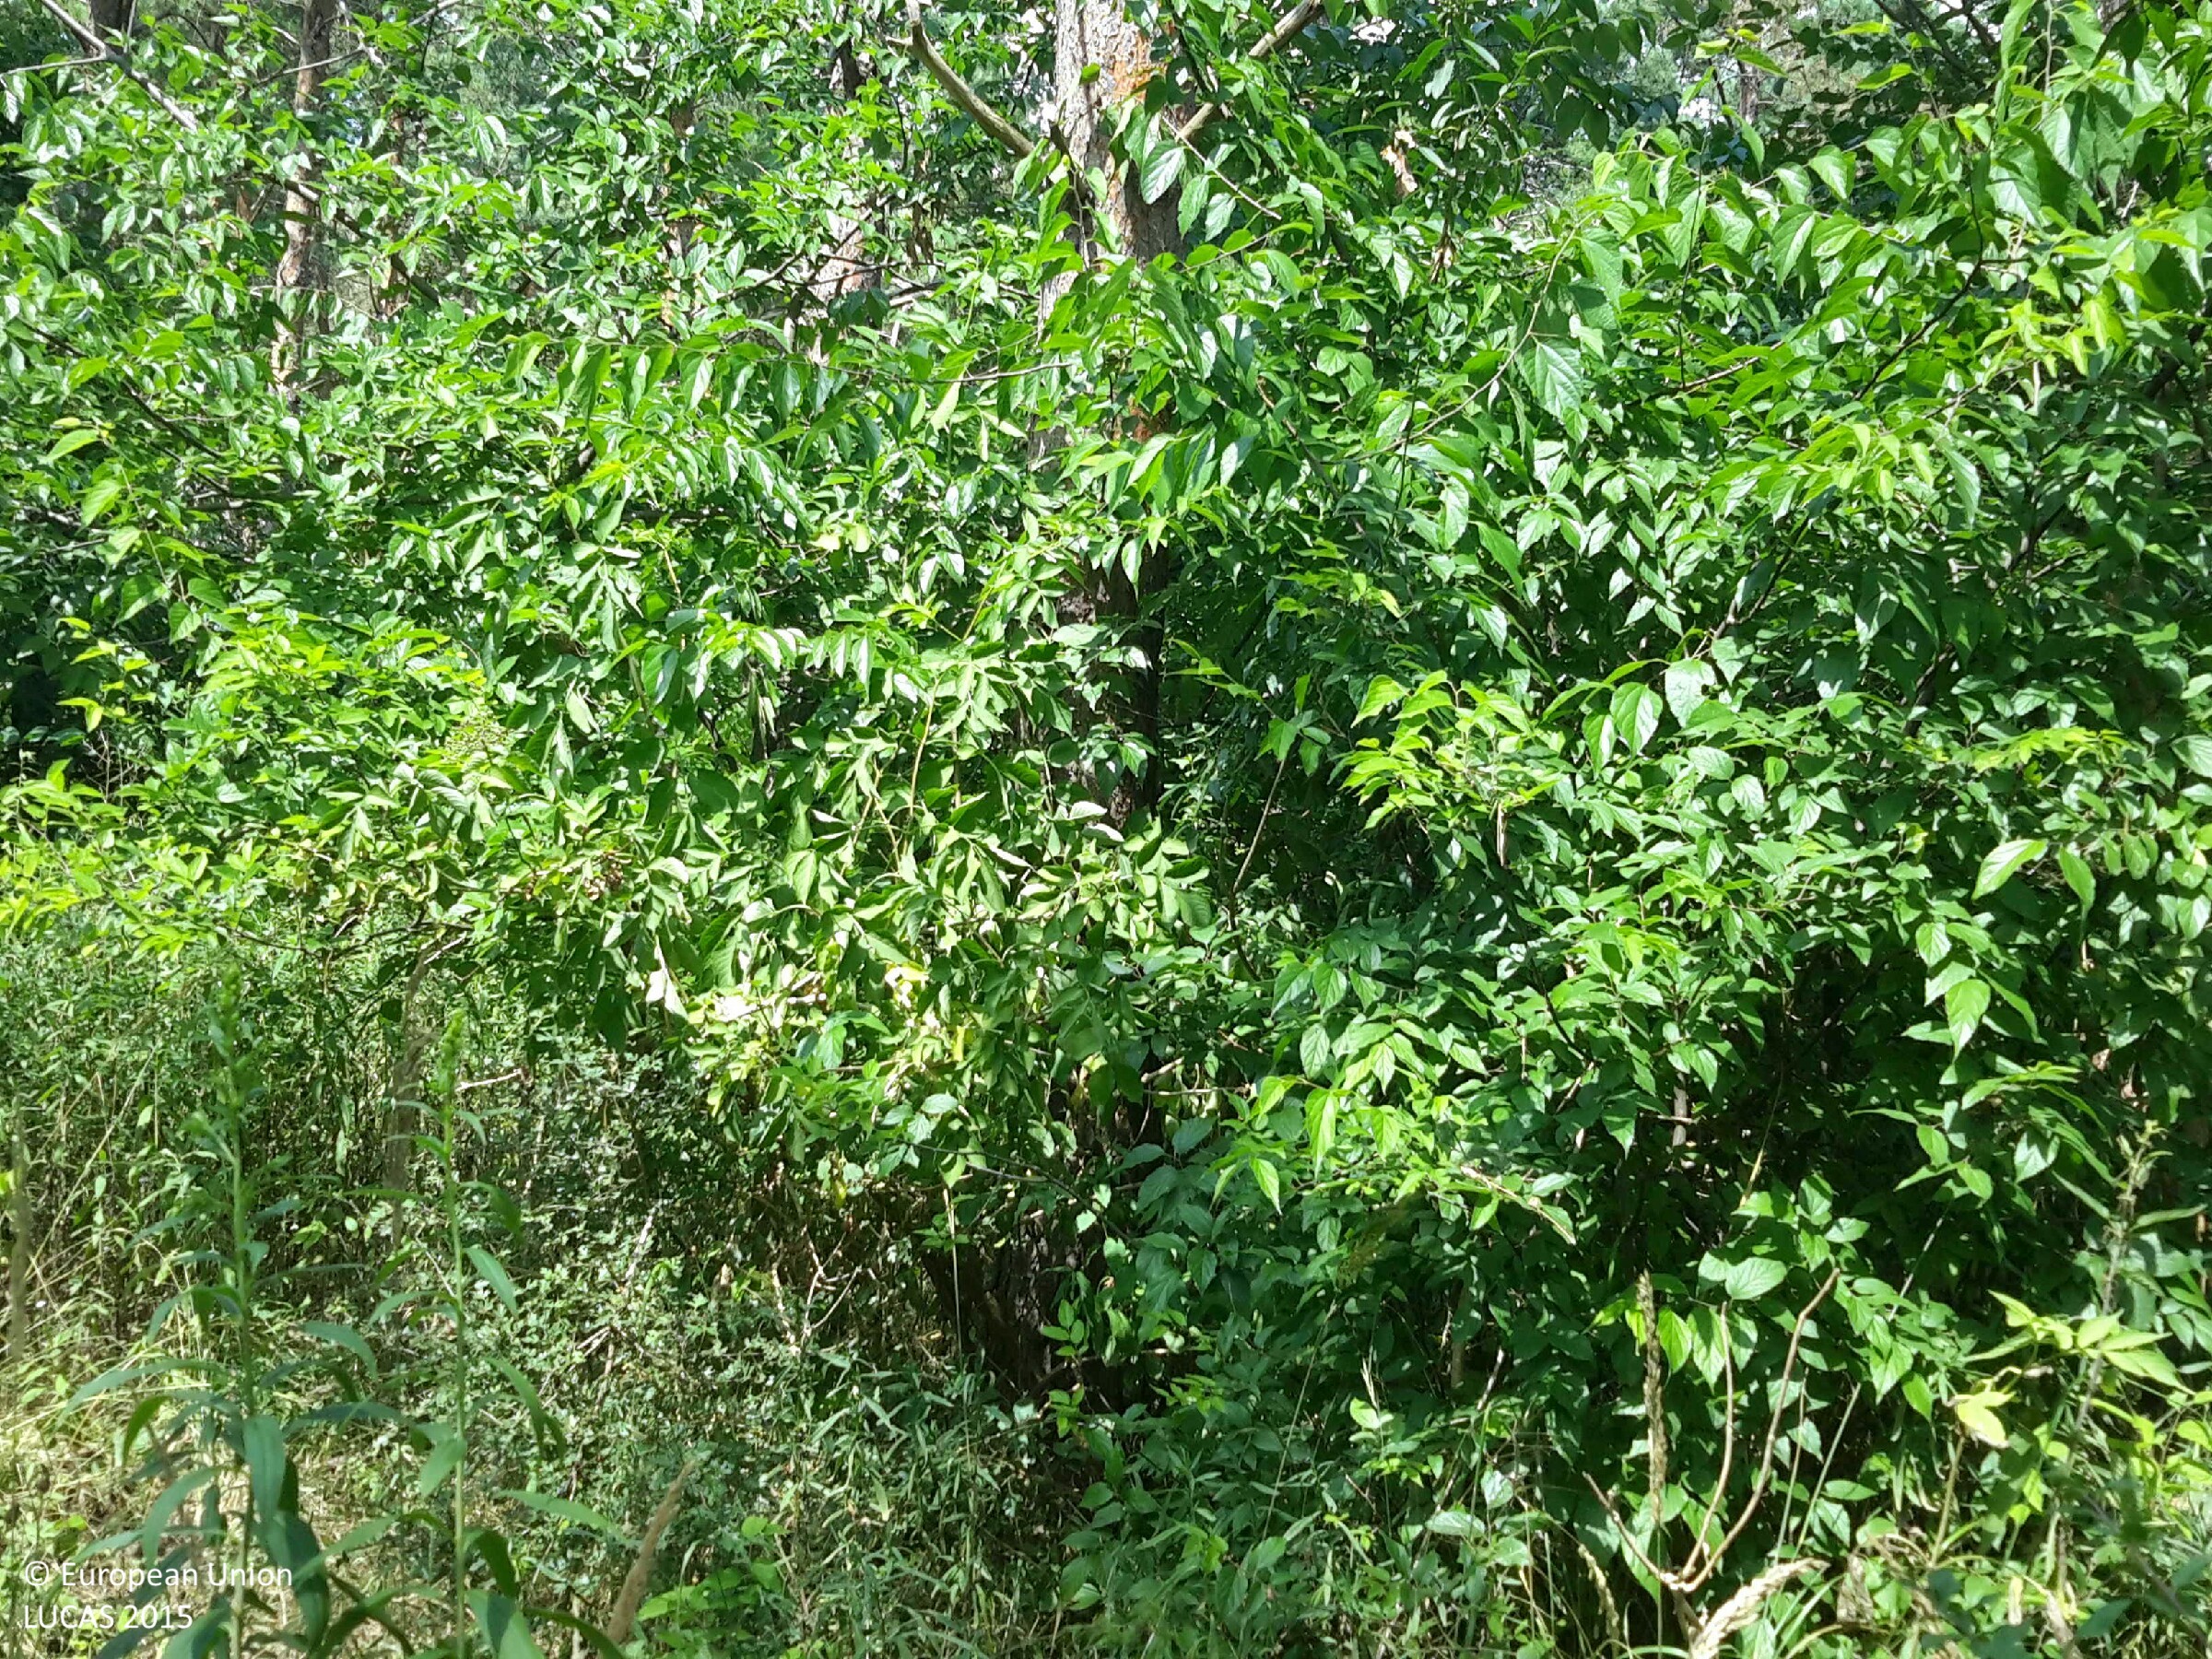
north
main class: Woodland
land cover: Broadleaved woodland
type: mesophytic deciduous forest
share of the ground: 50 - 75 %
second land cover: Spontaneously vegetated surfaces
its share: 25 - 50 %
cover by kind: broadleaved forest trees 70 %, shrubs 20 %, herbaceous plants 10 %
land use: Forestry
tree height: > 5 m
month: July
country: HU
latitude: 47.7235
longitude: 17.8899
